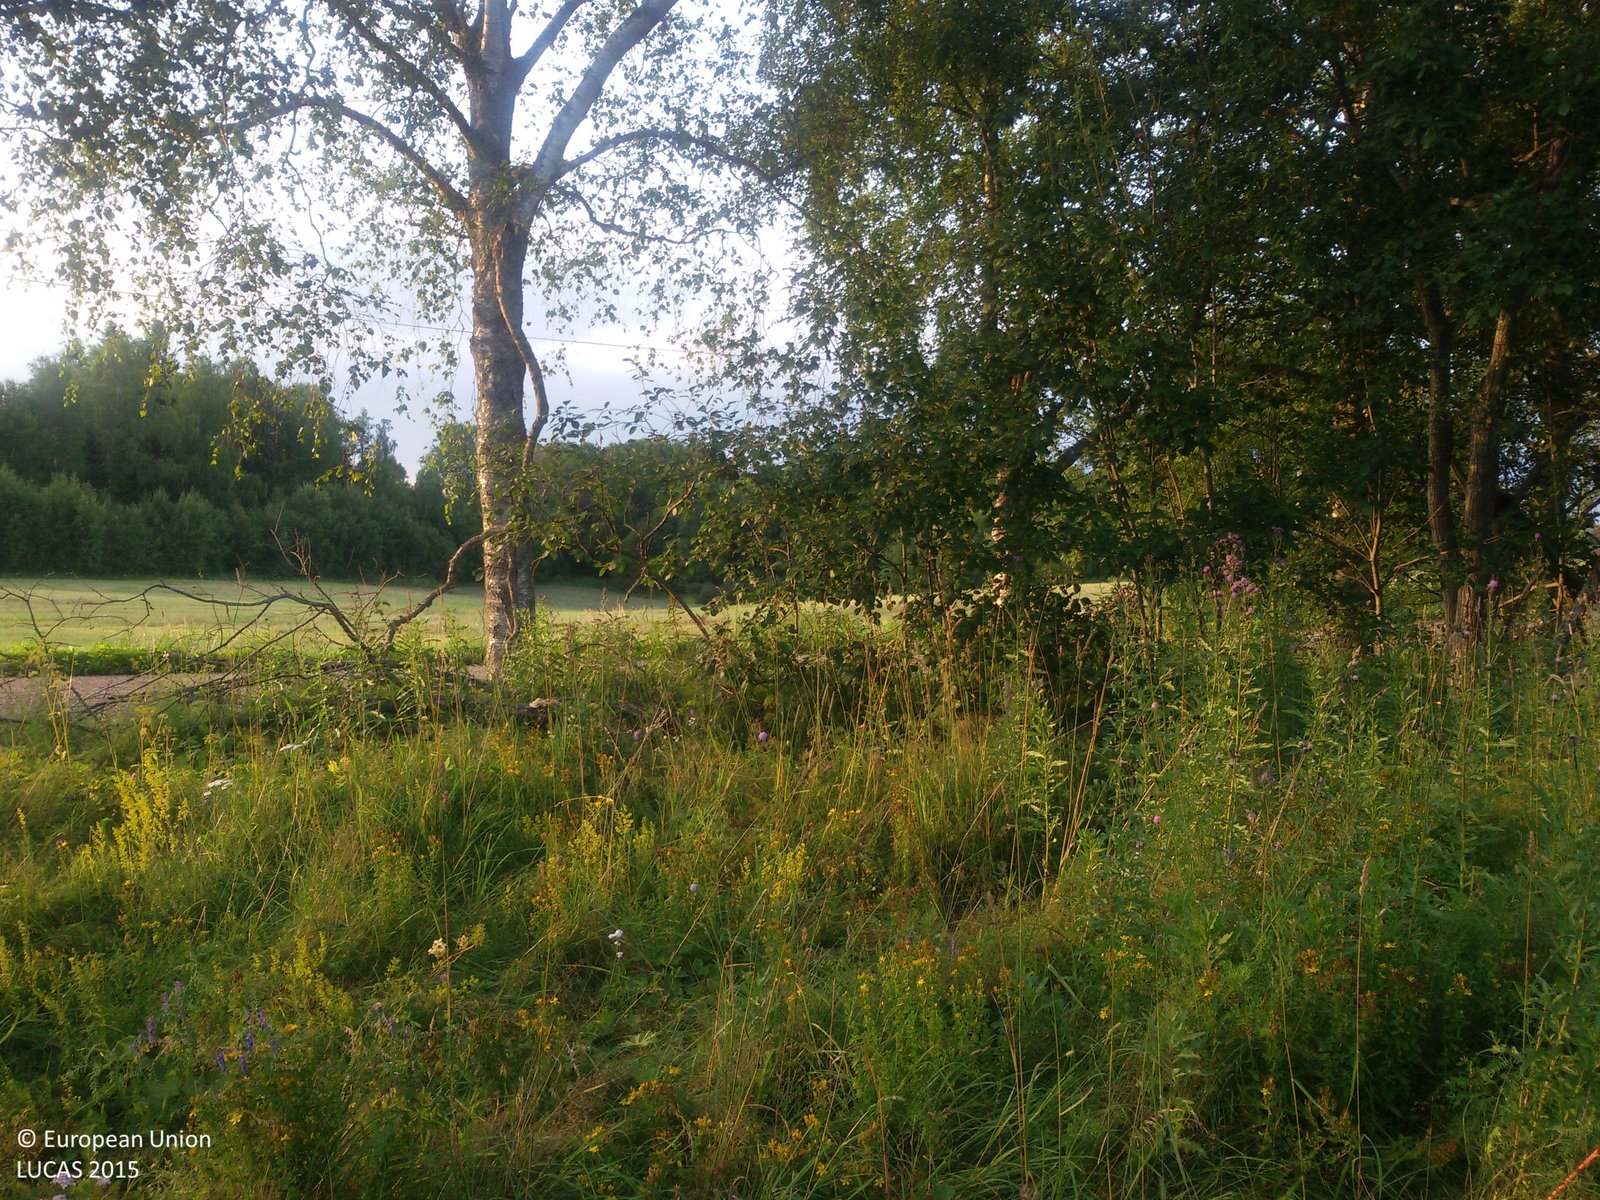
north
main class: Grassland
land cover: Grassland without tree/shrub cover
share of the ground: > 75 %
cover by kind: herbaceous plants 100 %
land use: Semi-natural and natural areas not in use
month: August
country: SE
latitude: 60.5712
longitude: 16.5384
